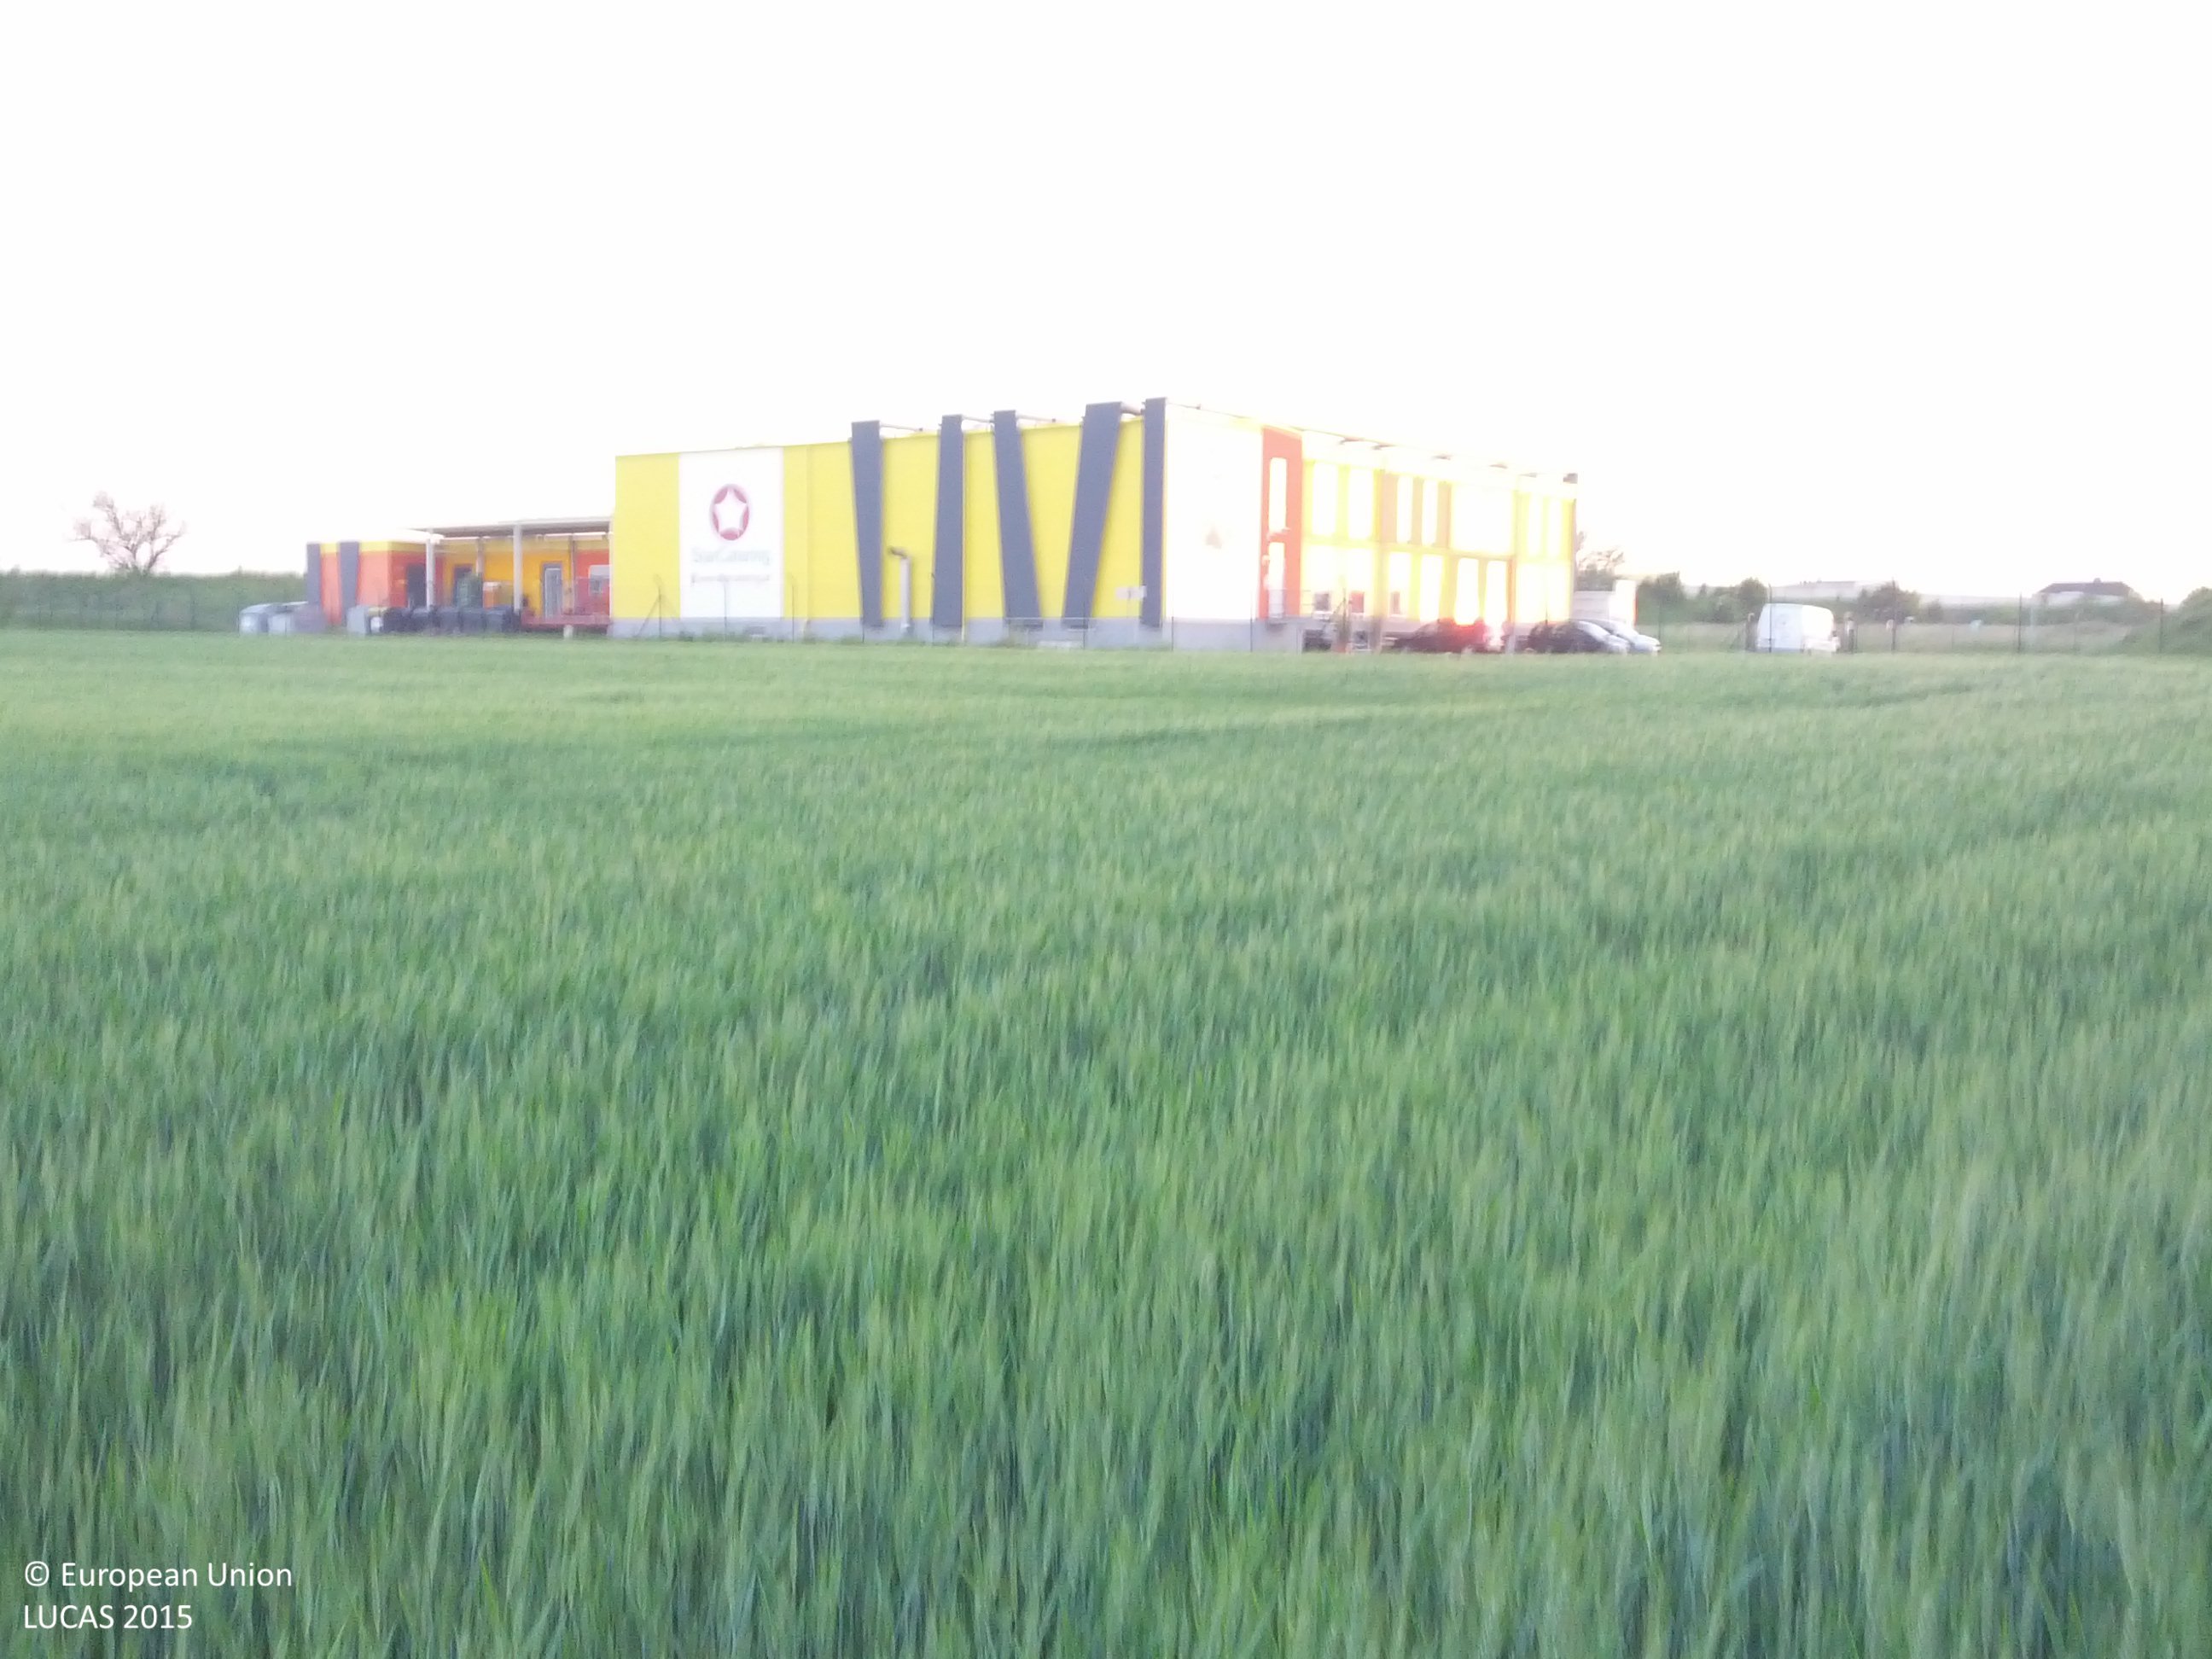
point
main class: Cropland
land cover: Common wheat
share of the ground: > 75 %
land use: Agriculture (excluding fallow land and kitchen gardens)
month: May
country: AT
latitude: 48.1143
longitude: 16.6278
